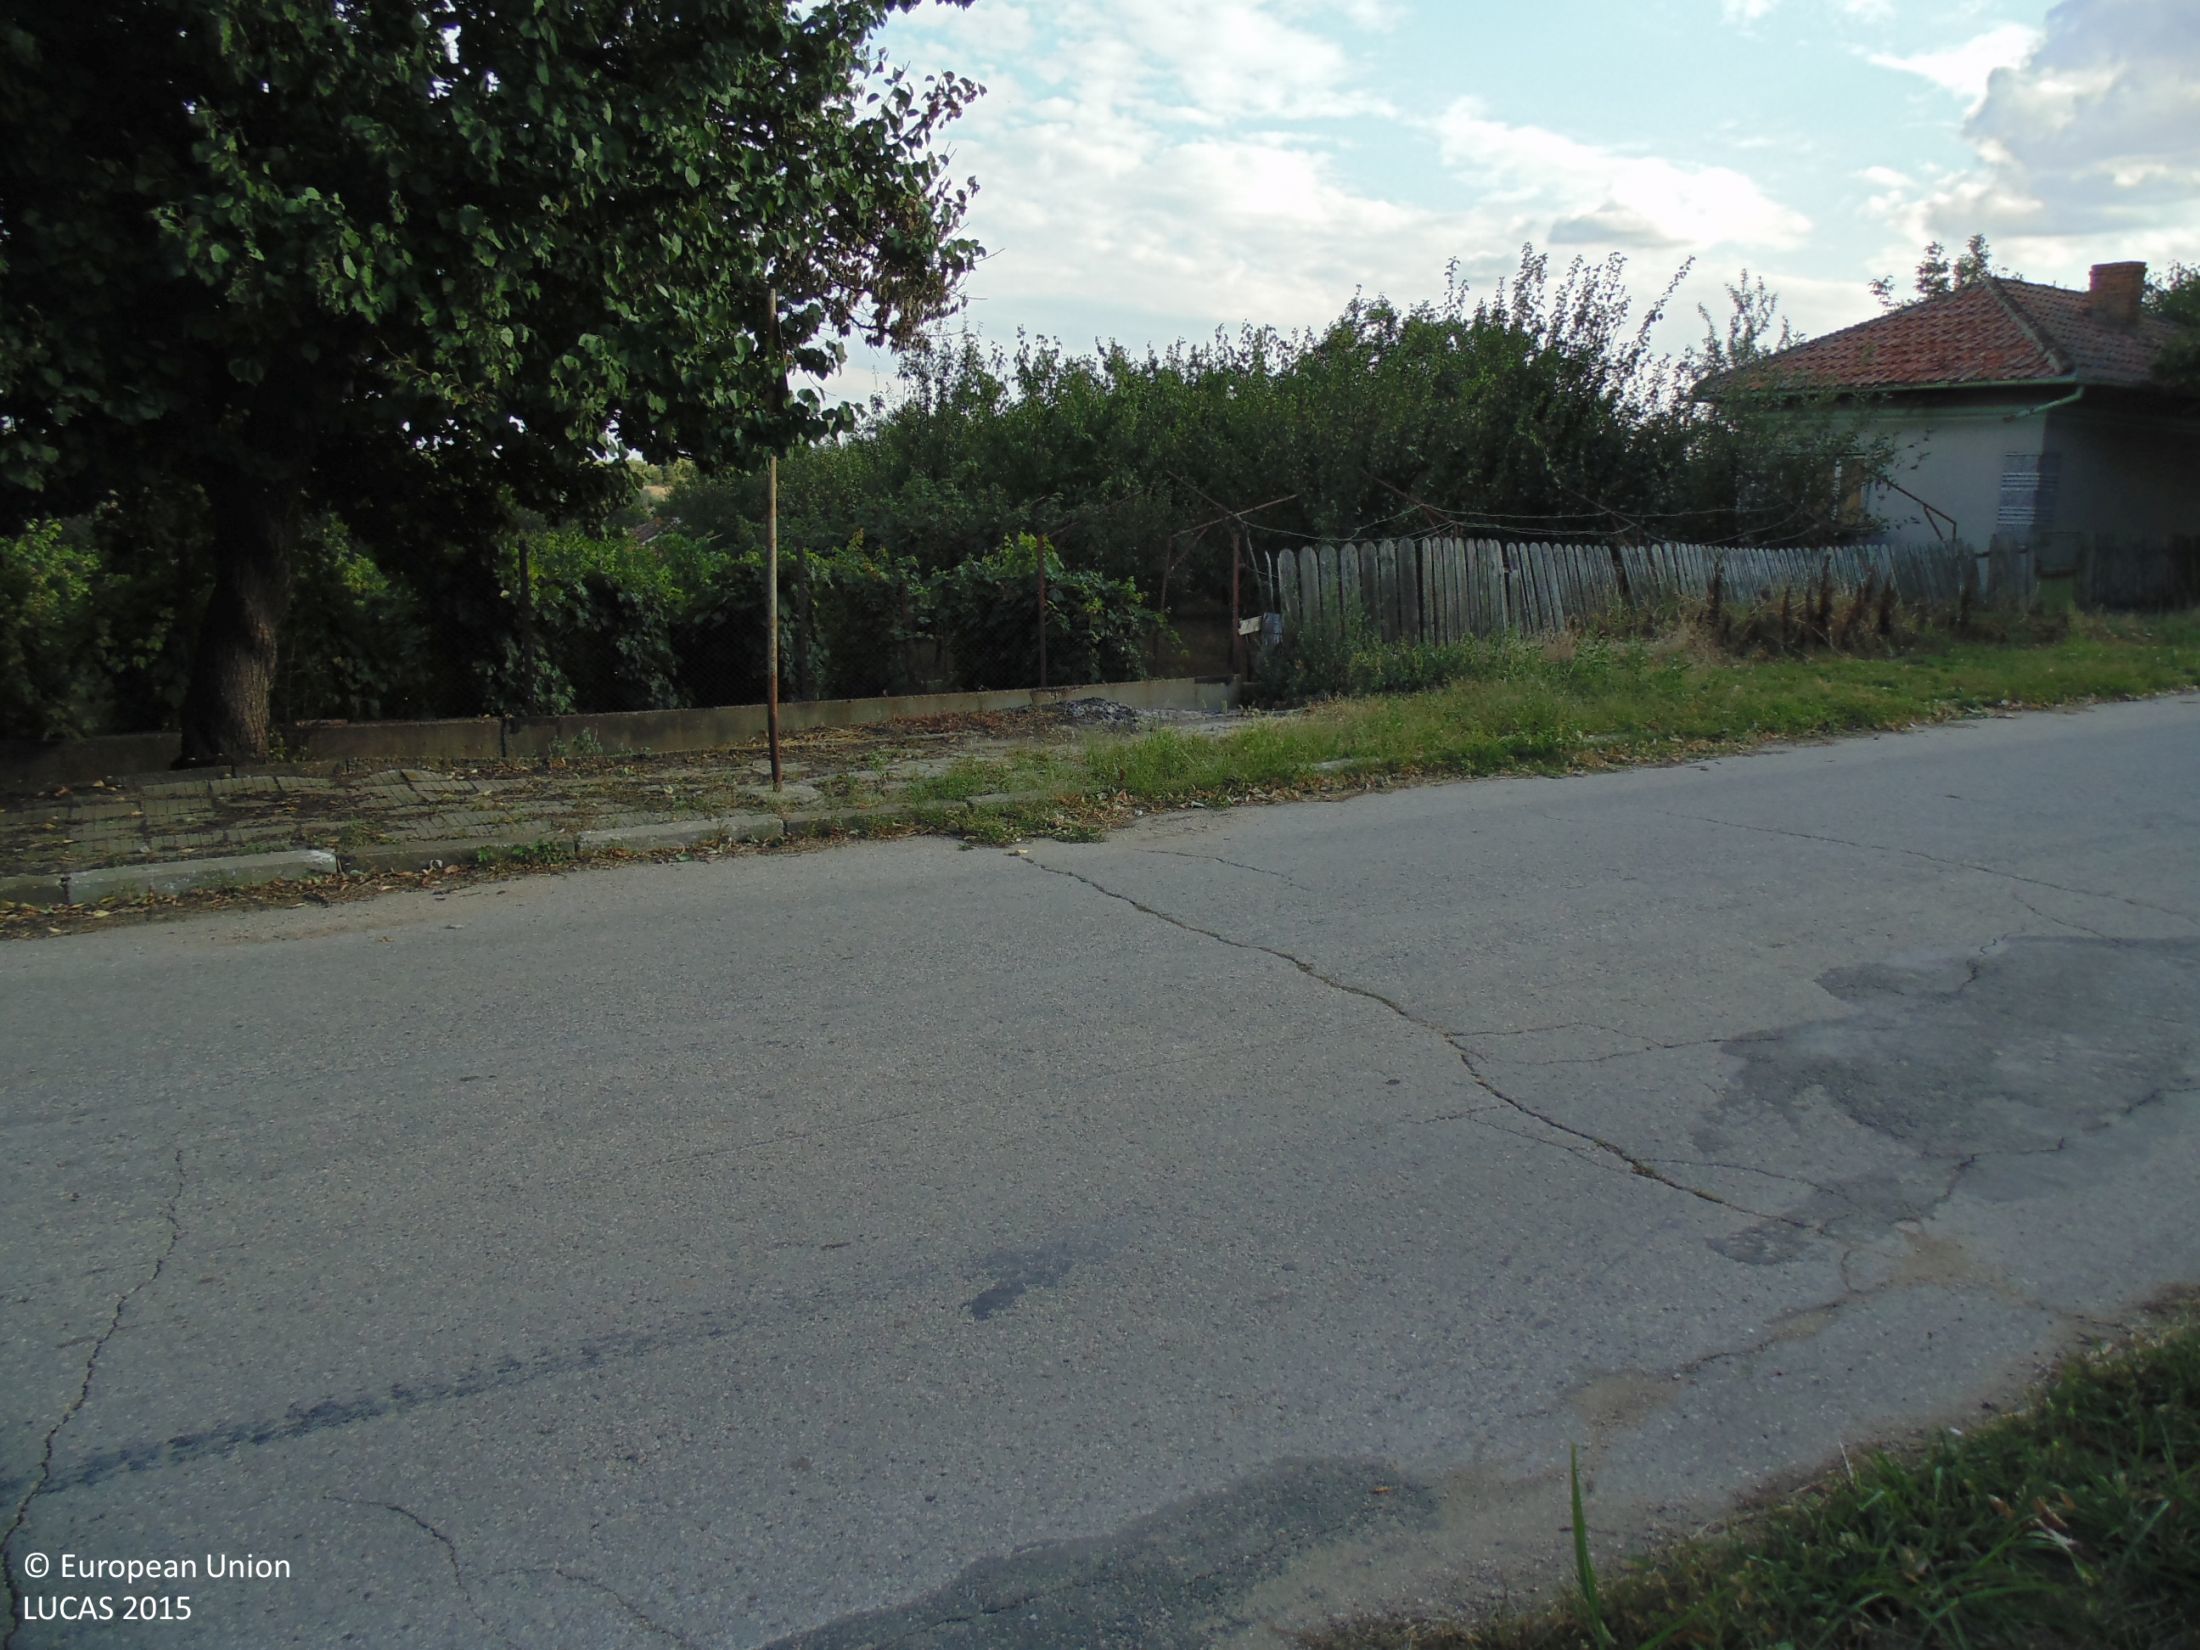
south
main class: Cropland
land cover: Other fruit trees and berries
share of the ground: 50 - 75 %
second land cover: Grassland without tree/shrub cover
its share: 50 - 75 %
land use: Kitchen garden
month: September
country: BG
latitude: 44.0485
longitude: 27.1649
